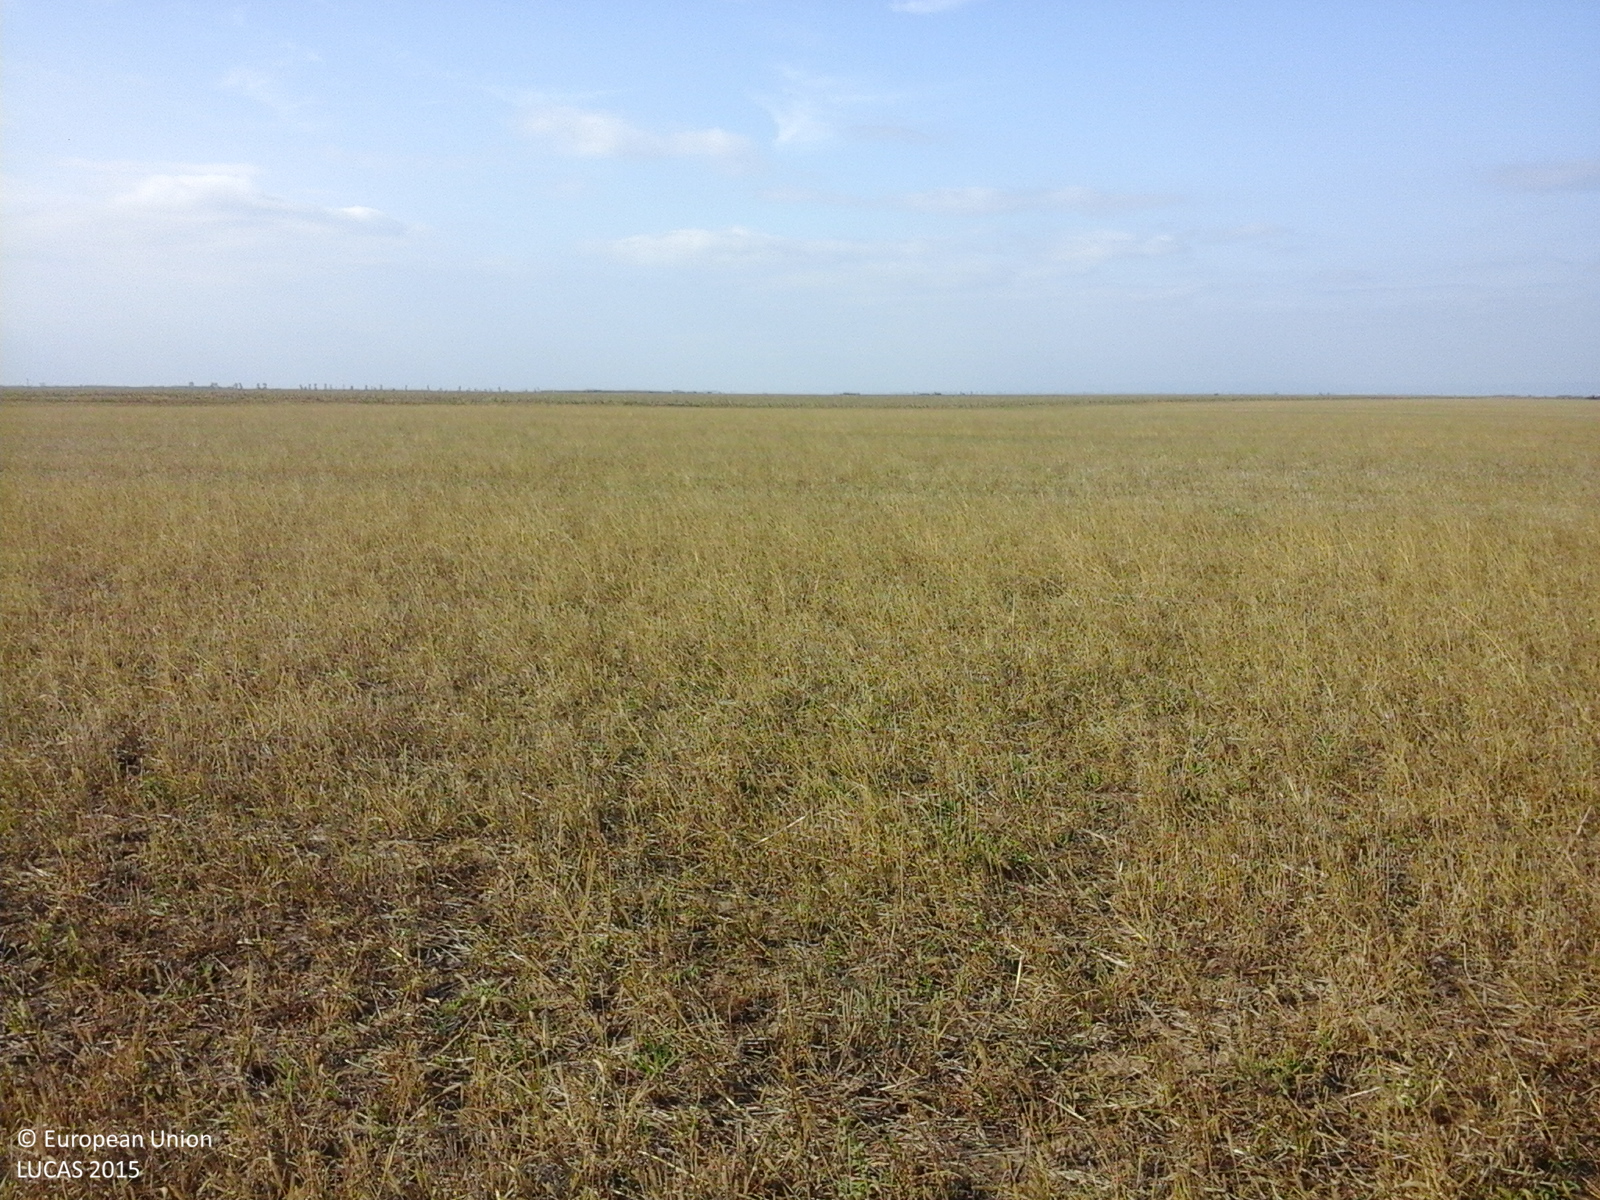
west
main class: Cropland
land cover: Barley
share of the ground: 25 - 50 %
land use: Agriculture (excluding fallow land and kitchen gardens)
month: October
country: RO
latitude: 45.2090
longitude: 27.2687
